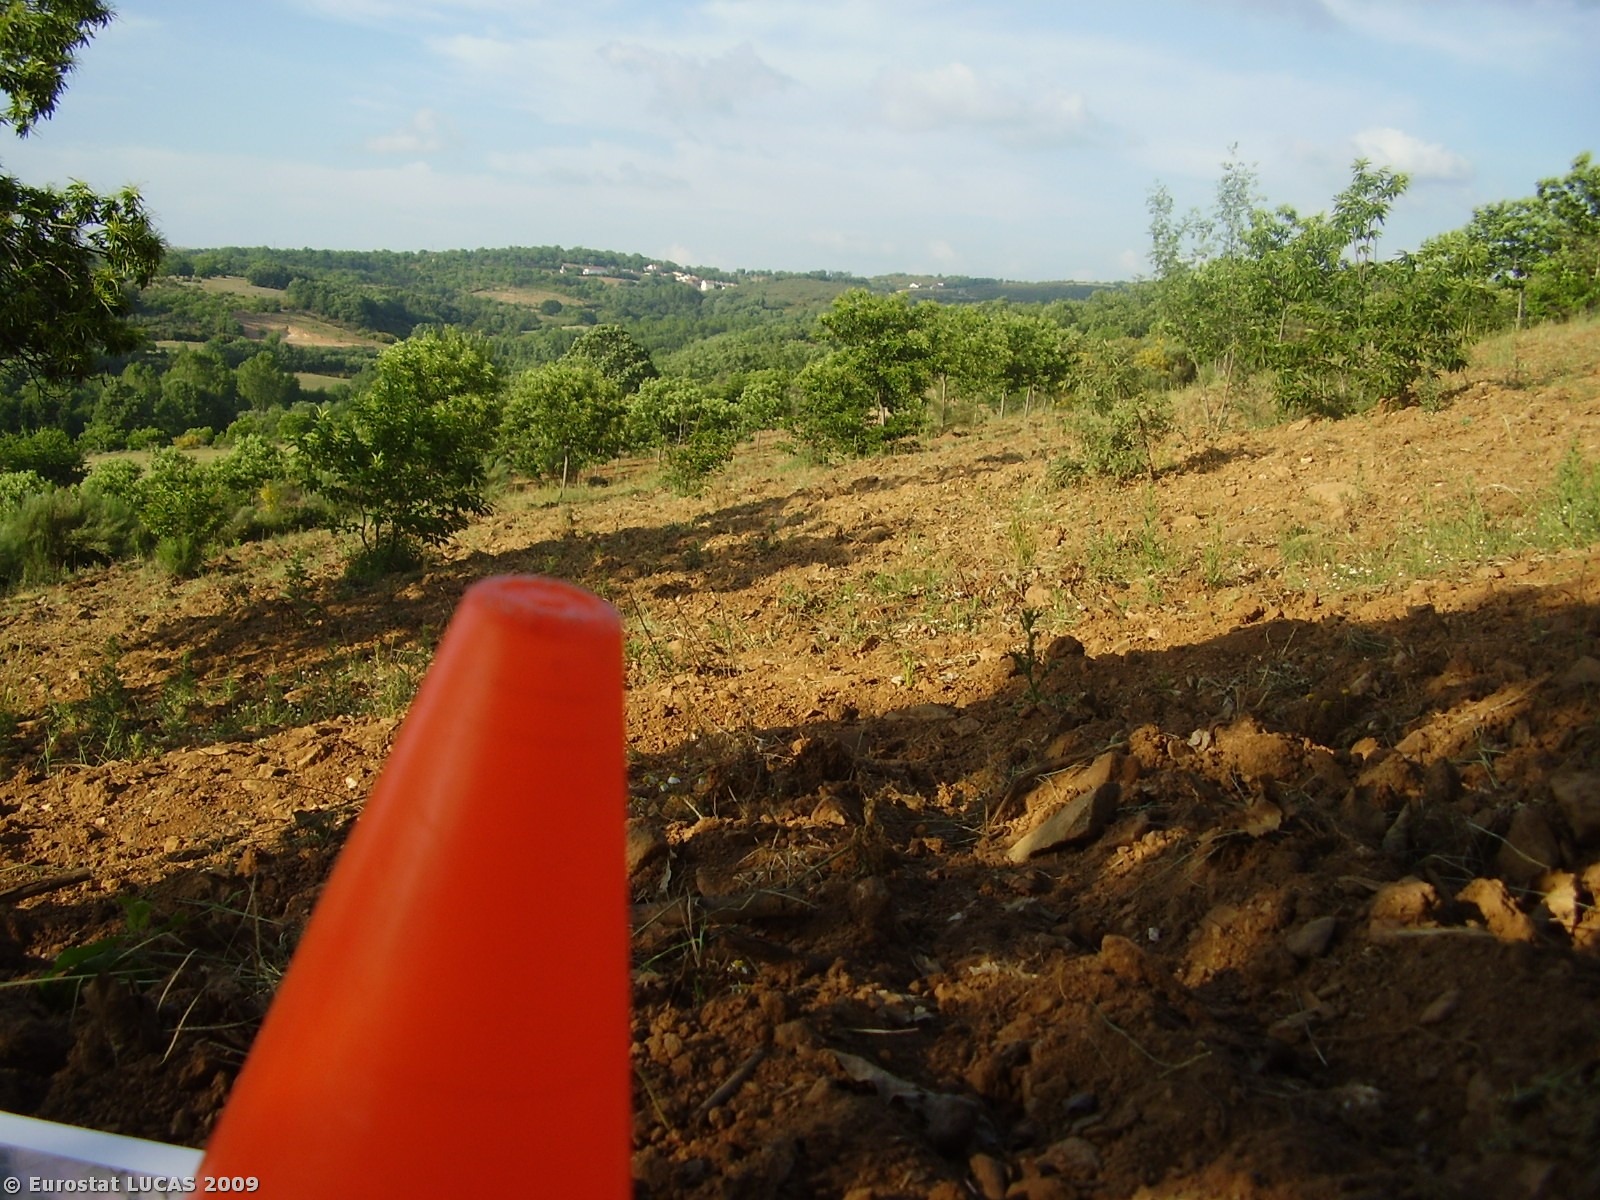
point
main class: Cropland
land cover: Nuts trees
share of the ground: 10 - 25 %
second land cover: Bare land
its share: < 10 %
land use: Agriculture (excluding fallow land and kitchen gardens)
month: June
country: PT
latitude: 41.6243
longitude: -6.8071
